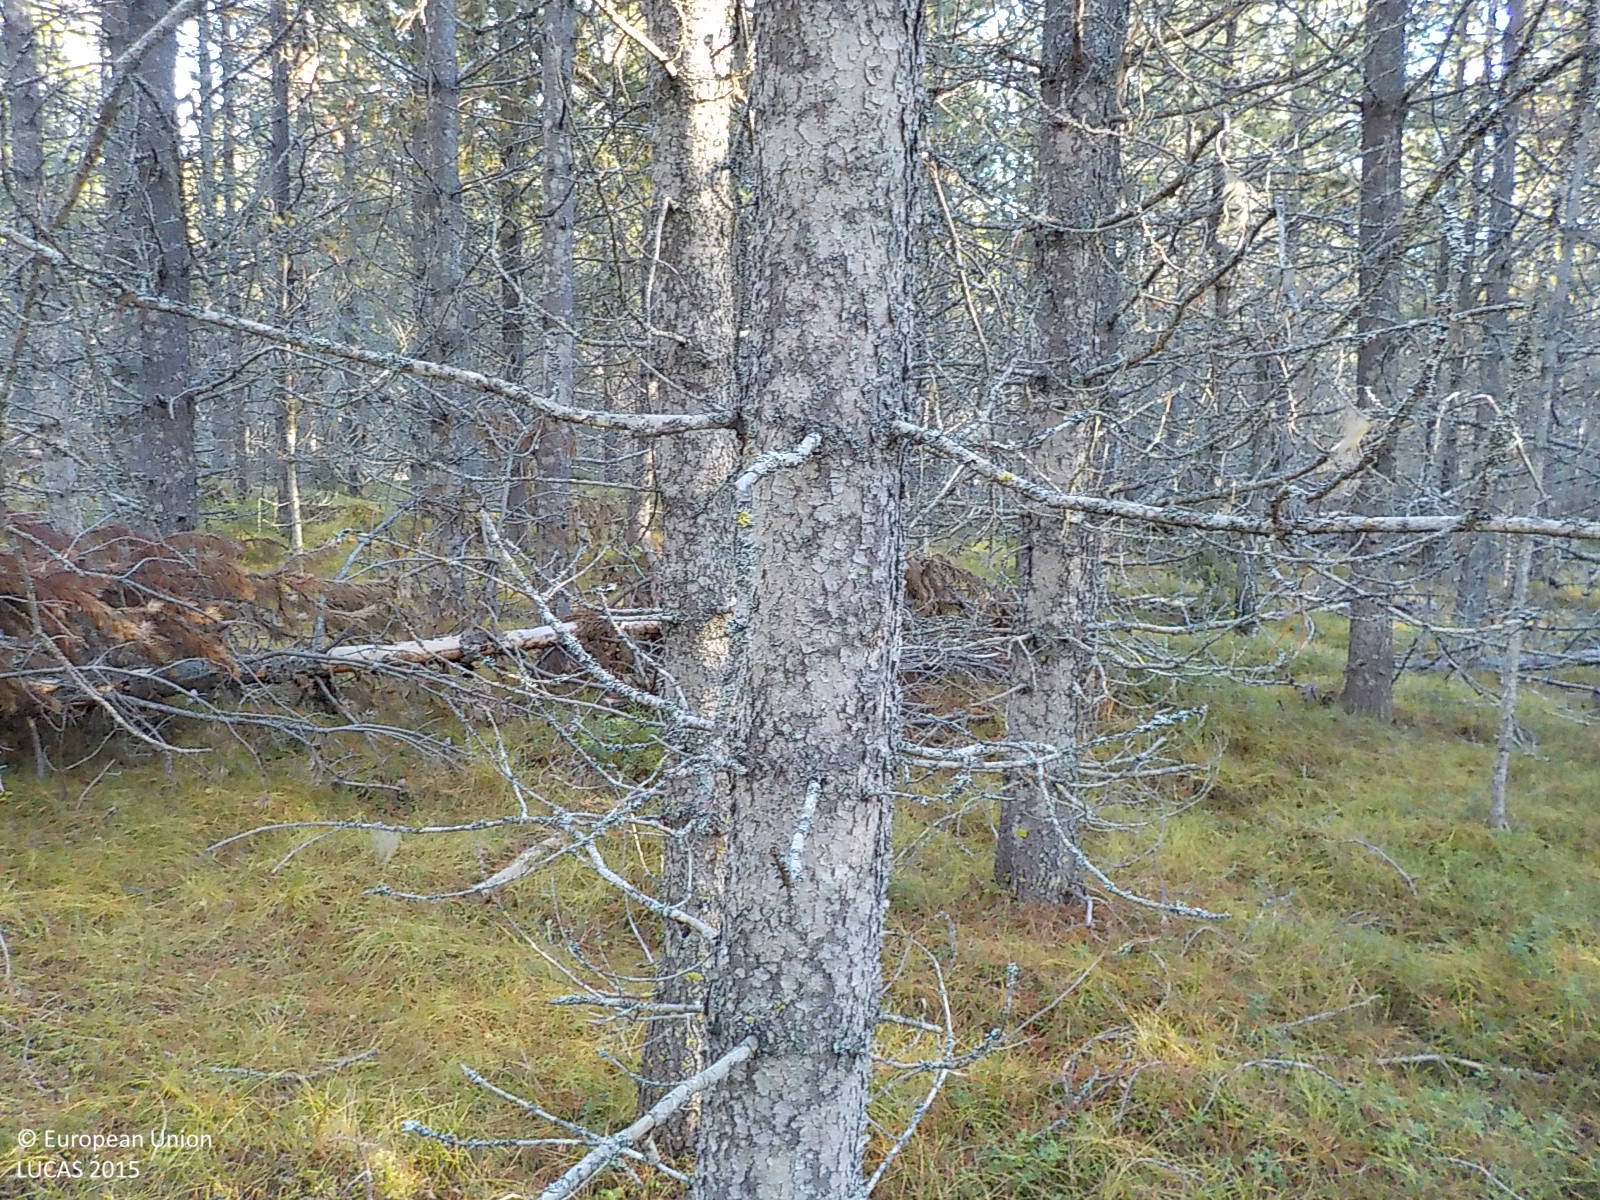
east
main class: Woodland
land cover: Other coniferous woodland
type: boreal forest
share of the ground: > 75 %
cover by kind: coniferous forest trees 75 %, shrubs 25 %
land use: Forestry
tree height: > 5 m
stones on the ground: < 10 %
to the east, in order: Other coniferous woodland
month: November
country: SE
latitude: 63.2134
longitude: 16.5188
